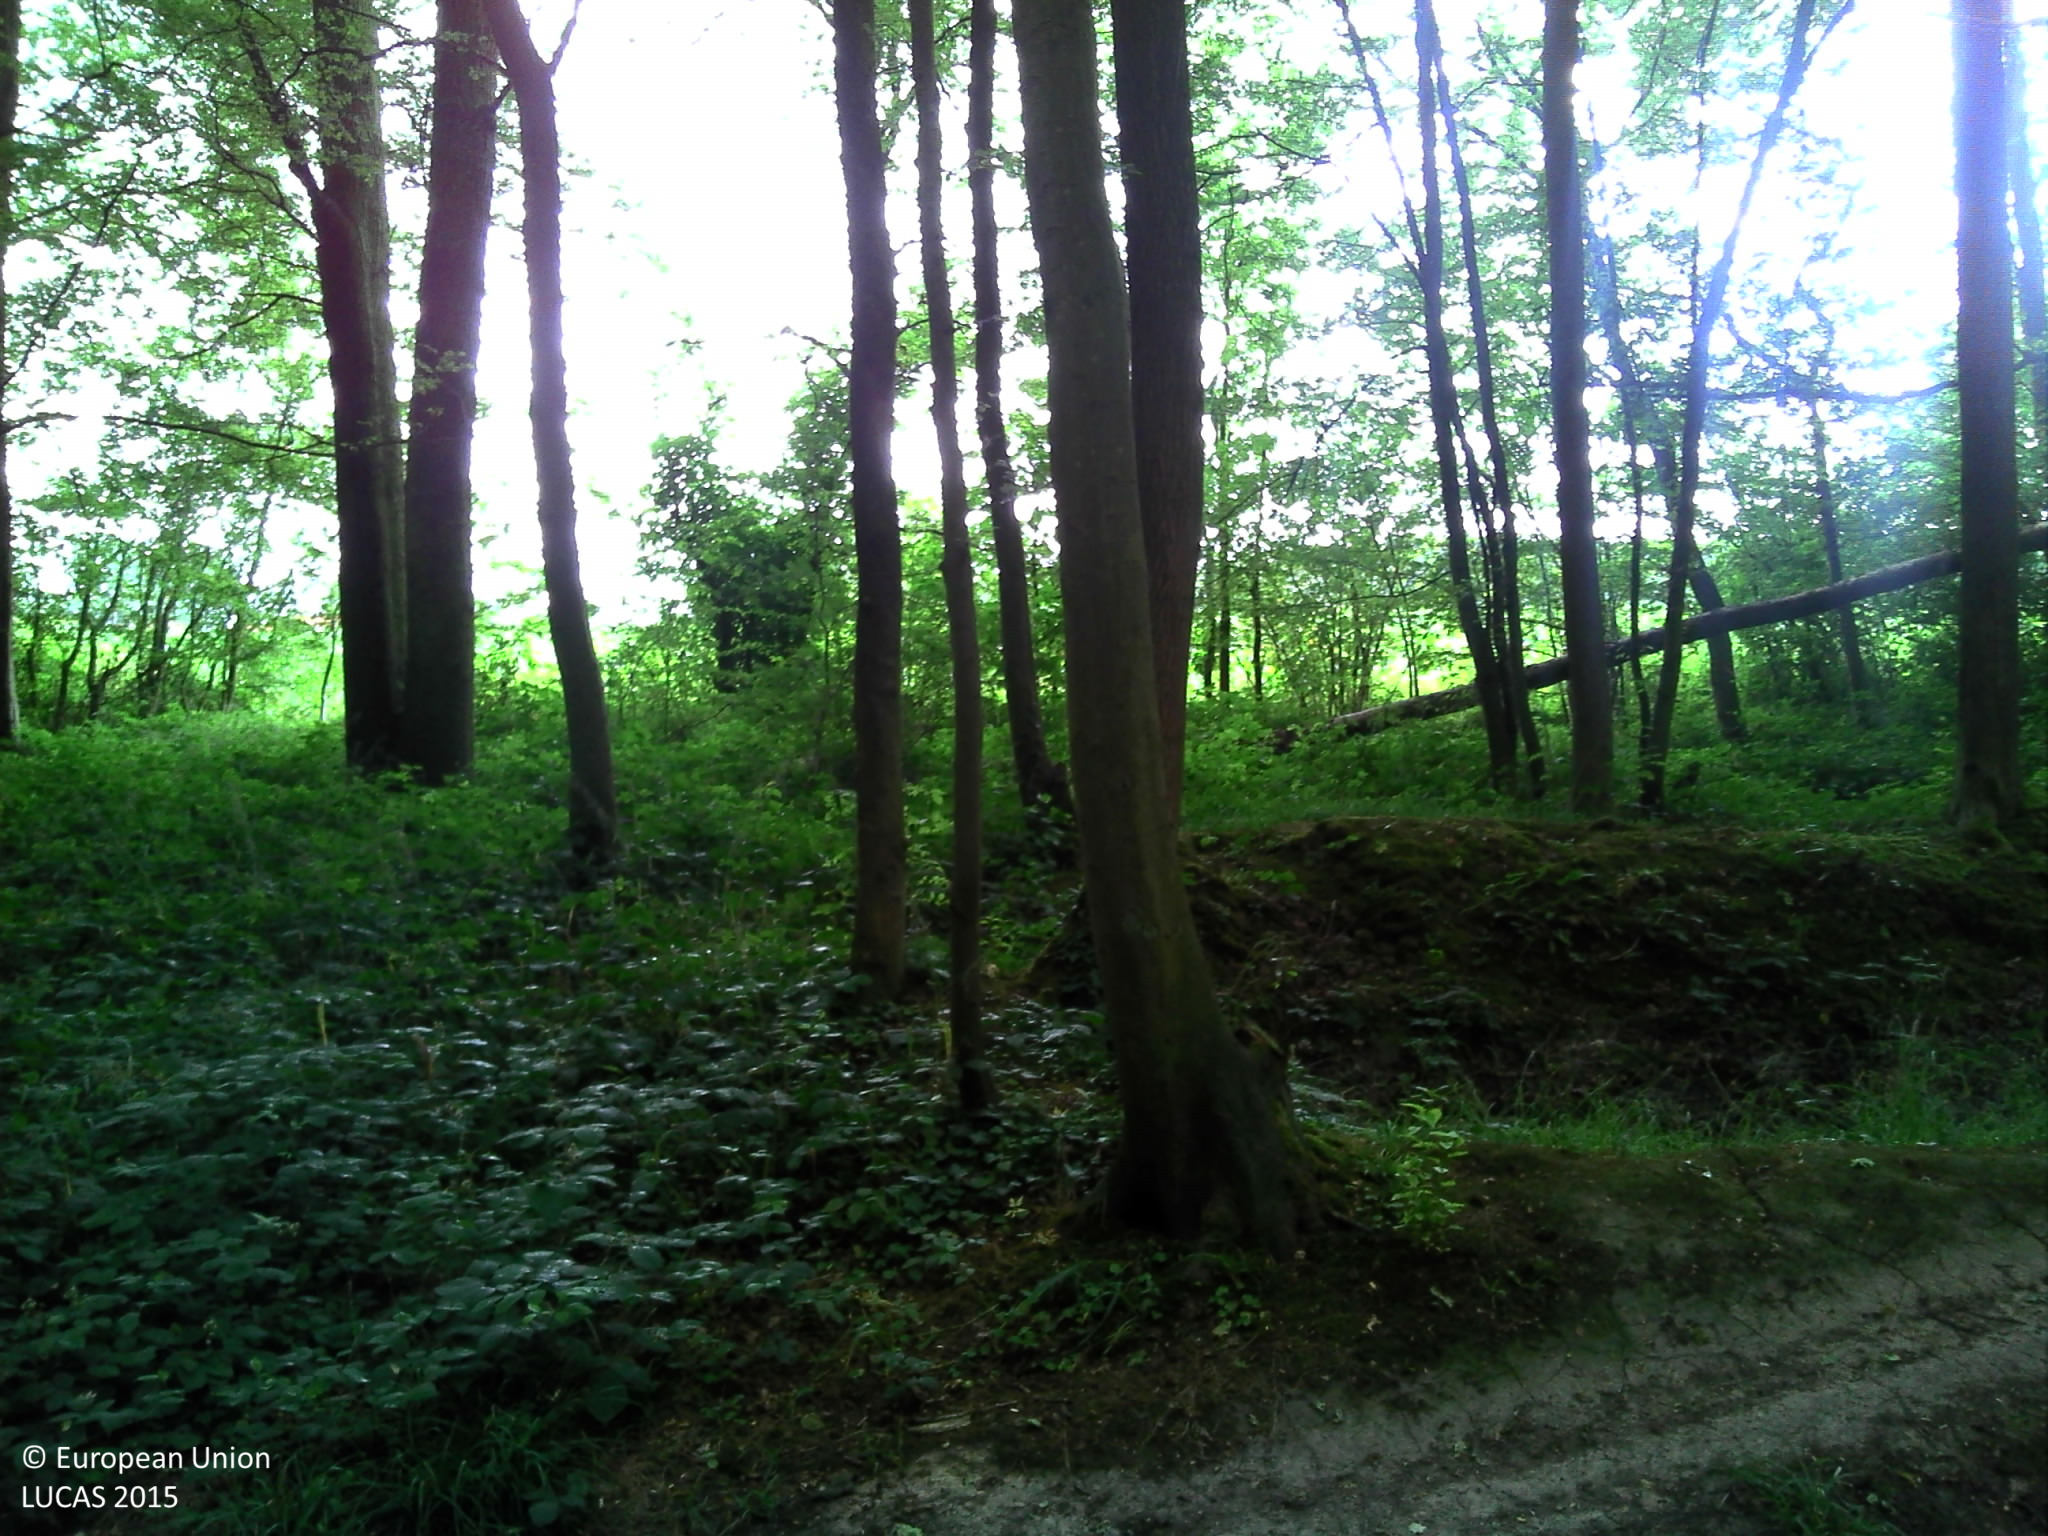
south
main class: Woodland
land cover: Broadleaved woodland
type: acidophilous oak and oak-birch forest
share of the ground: > 75 %
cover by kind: broadleaved forest trees 80 %, herbaceous plants 15 %, lichens and mosses 5 %
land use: Forestry
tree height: > 5 m
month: July
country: FR
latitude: 50.4966
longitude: 3.0686
